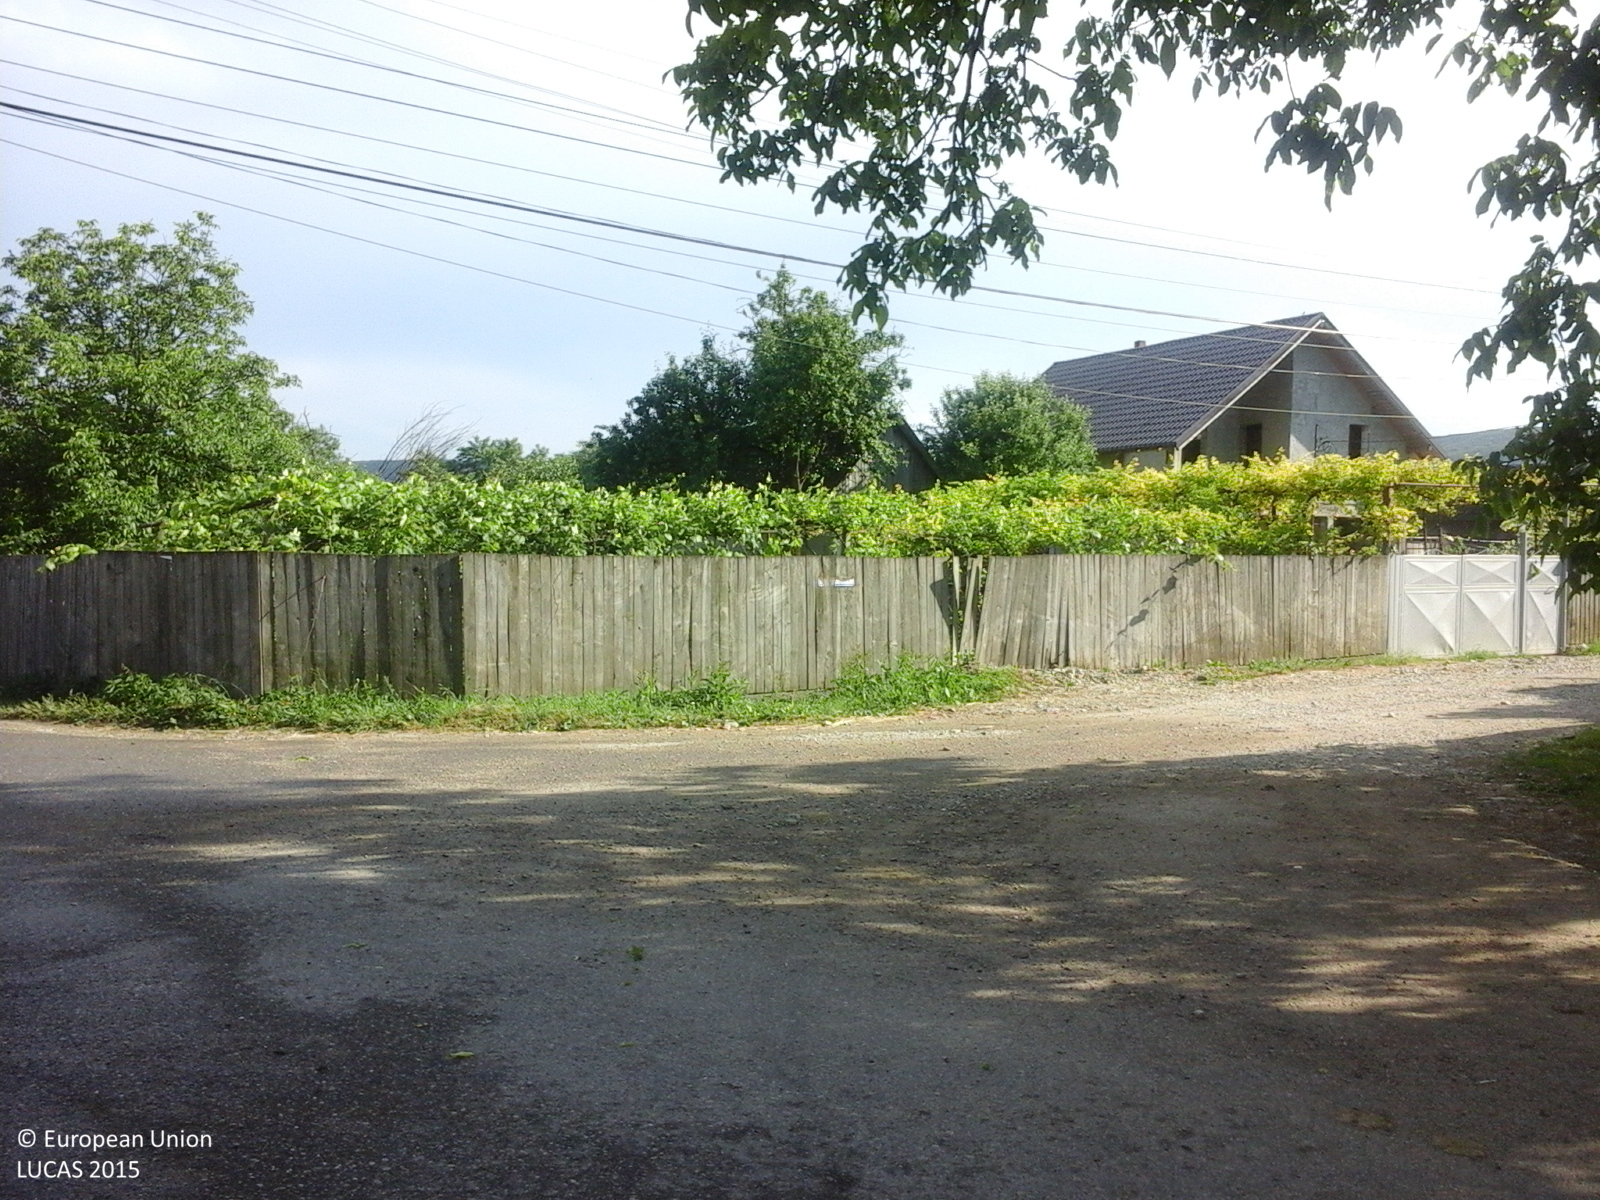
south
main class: Grassland
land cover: Grassland without tree/shrub cover
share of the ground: 50 - 75 %
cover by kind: herbaceous plants 100 %
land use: Agriculture (excluding fallow land and kitchen gardens)
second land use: Residential
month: June
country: RO
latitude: 46.6634
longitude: 26.8074
